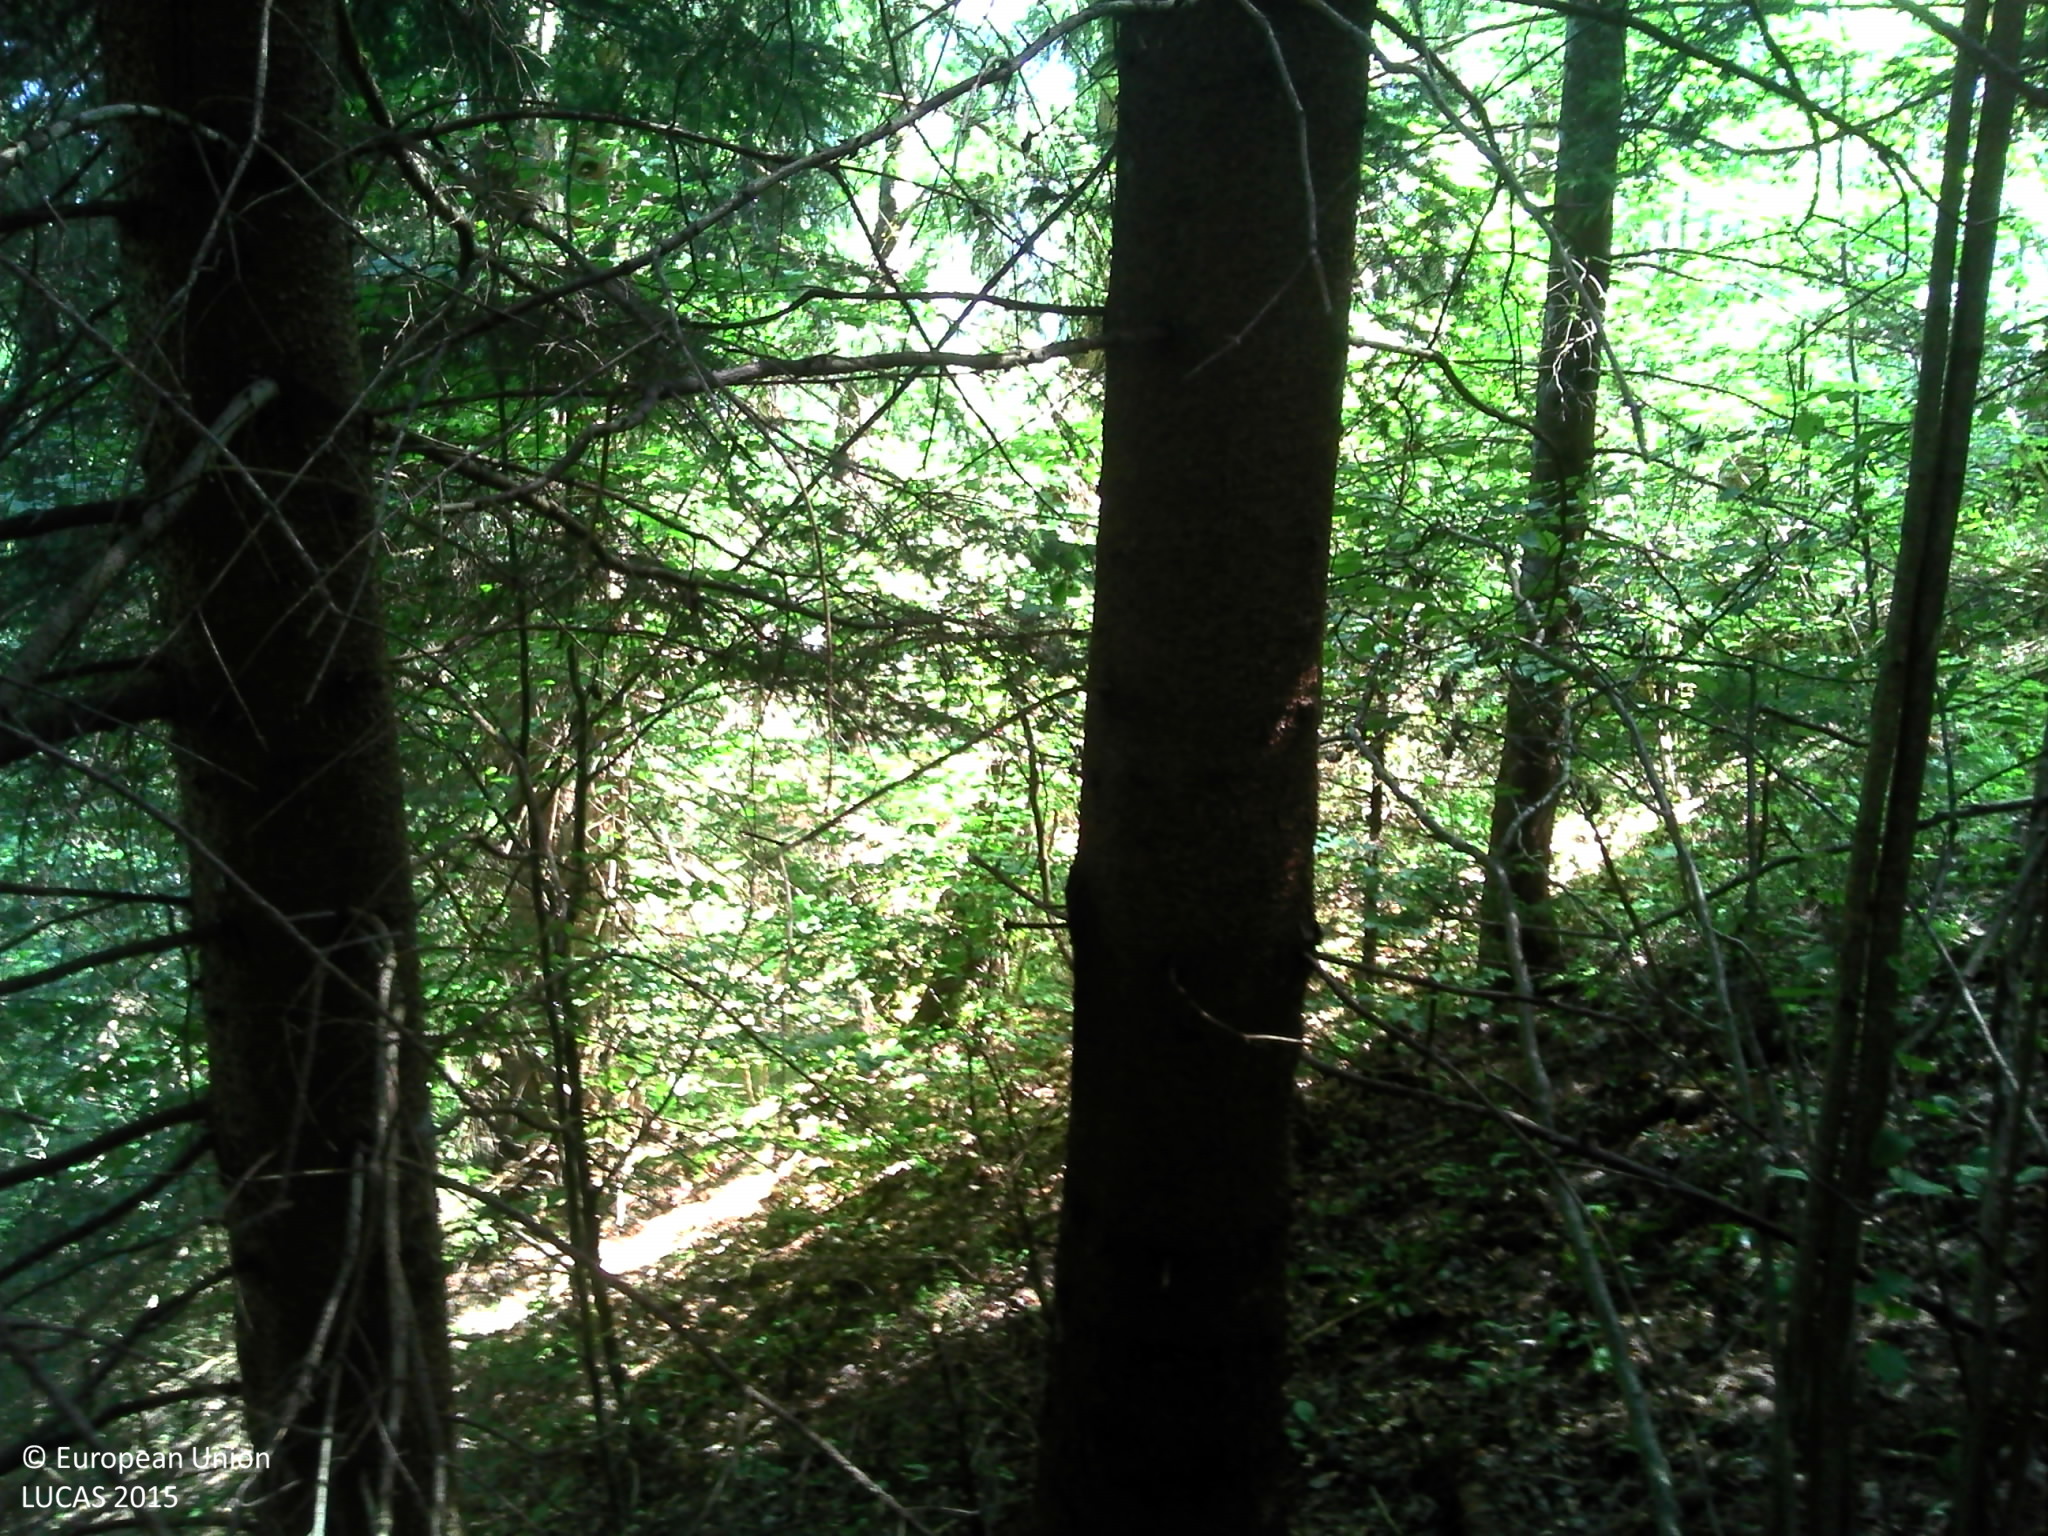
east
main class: Woodland
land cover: Spruce dominated coniferous woodland
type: alpine coniferous forest
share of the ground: > 75 %
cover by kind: coniferous forest trees 70 %, broadleaved forest trees 15 %, herbaceous plants 10 %, lichens and mosses 5 %
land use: Forestry
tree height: > 5 m
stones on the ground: < 10 %
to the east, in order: Spruce dominated coniferous woodland; Rivers and streams; Broadleaved woodland; Artificial constructions in urban areas; Broadleaved woodland; Other fresh vegetables; Grassland with sparse tree/shrub cover
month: July
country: FR
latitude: 46.1667
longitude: 6.4678
